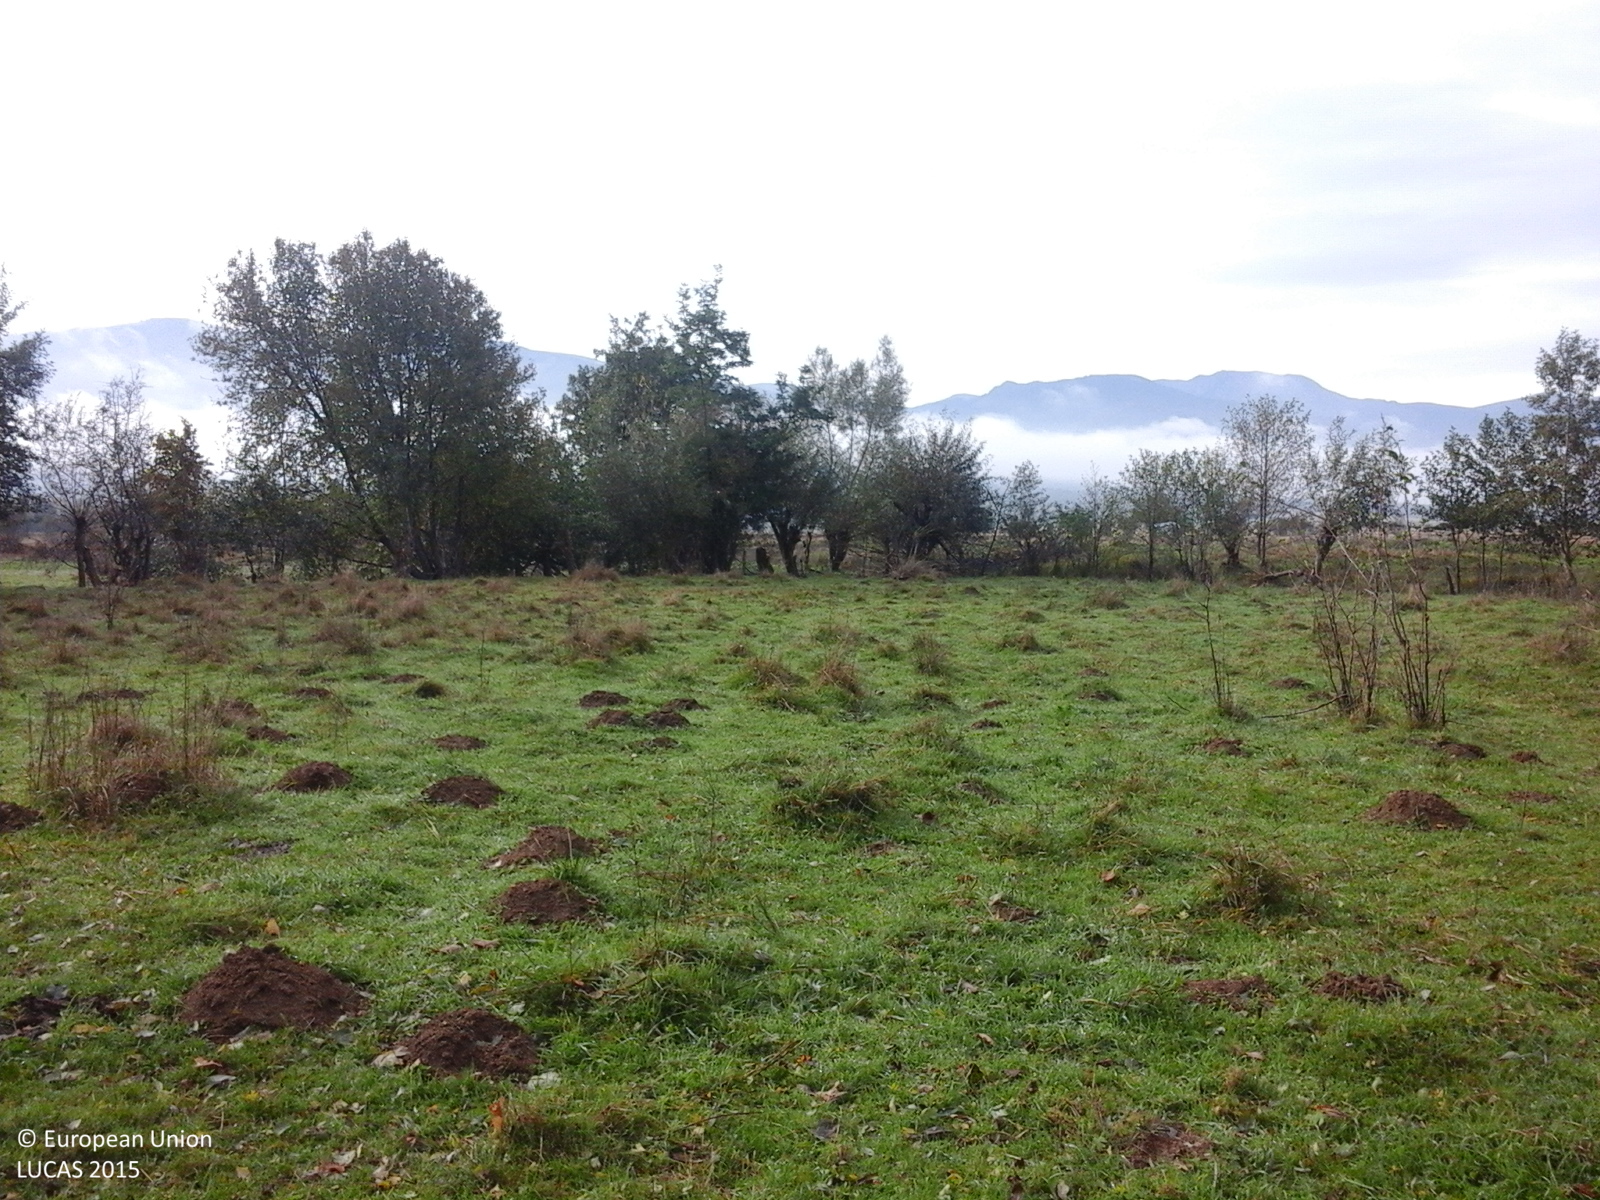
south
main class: Grassland
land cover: Grassland with sparse tree/shrub cover
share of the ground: > 75 %
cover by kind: herbaceous plants 90 %, broadleaved forest trees 5 %, shrubs 5 %
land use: Agriculture (excluding fallow land and kitchen gardens)
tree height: > 5 m
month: October
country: RO
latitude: 45.7241
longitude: 25.0091
